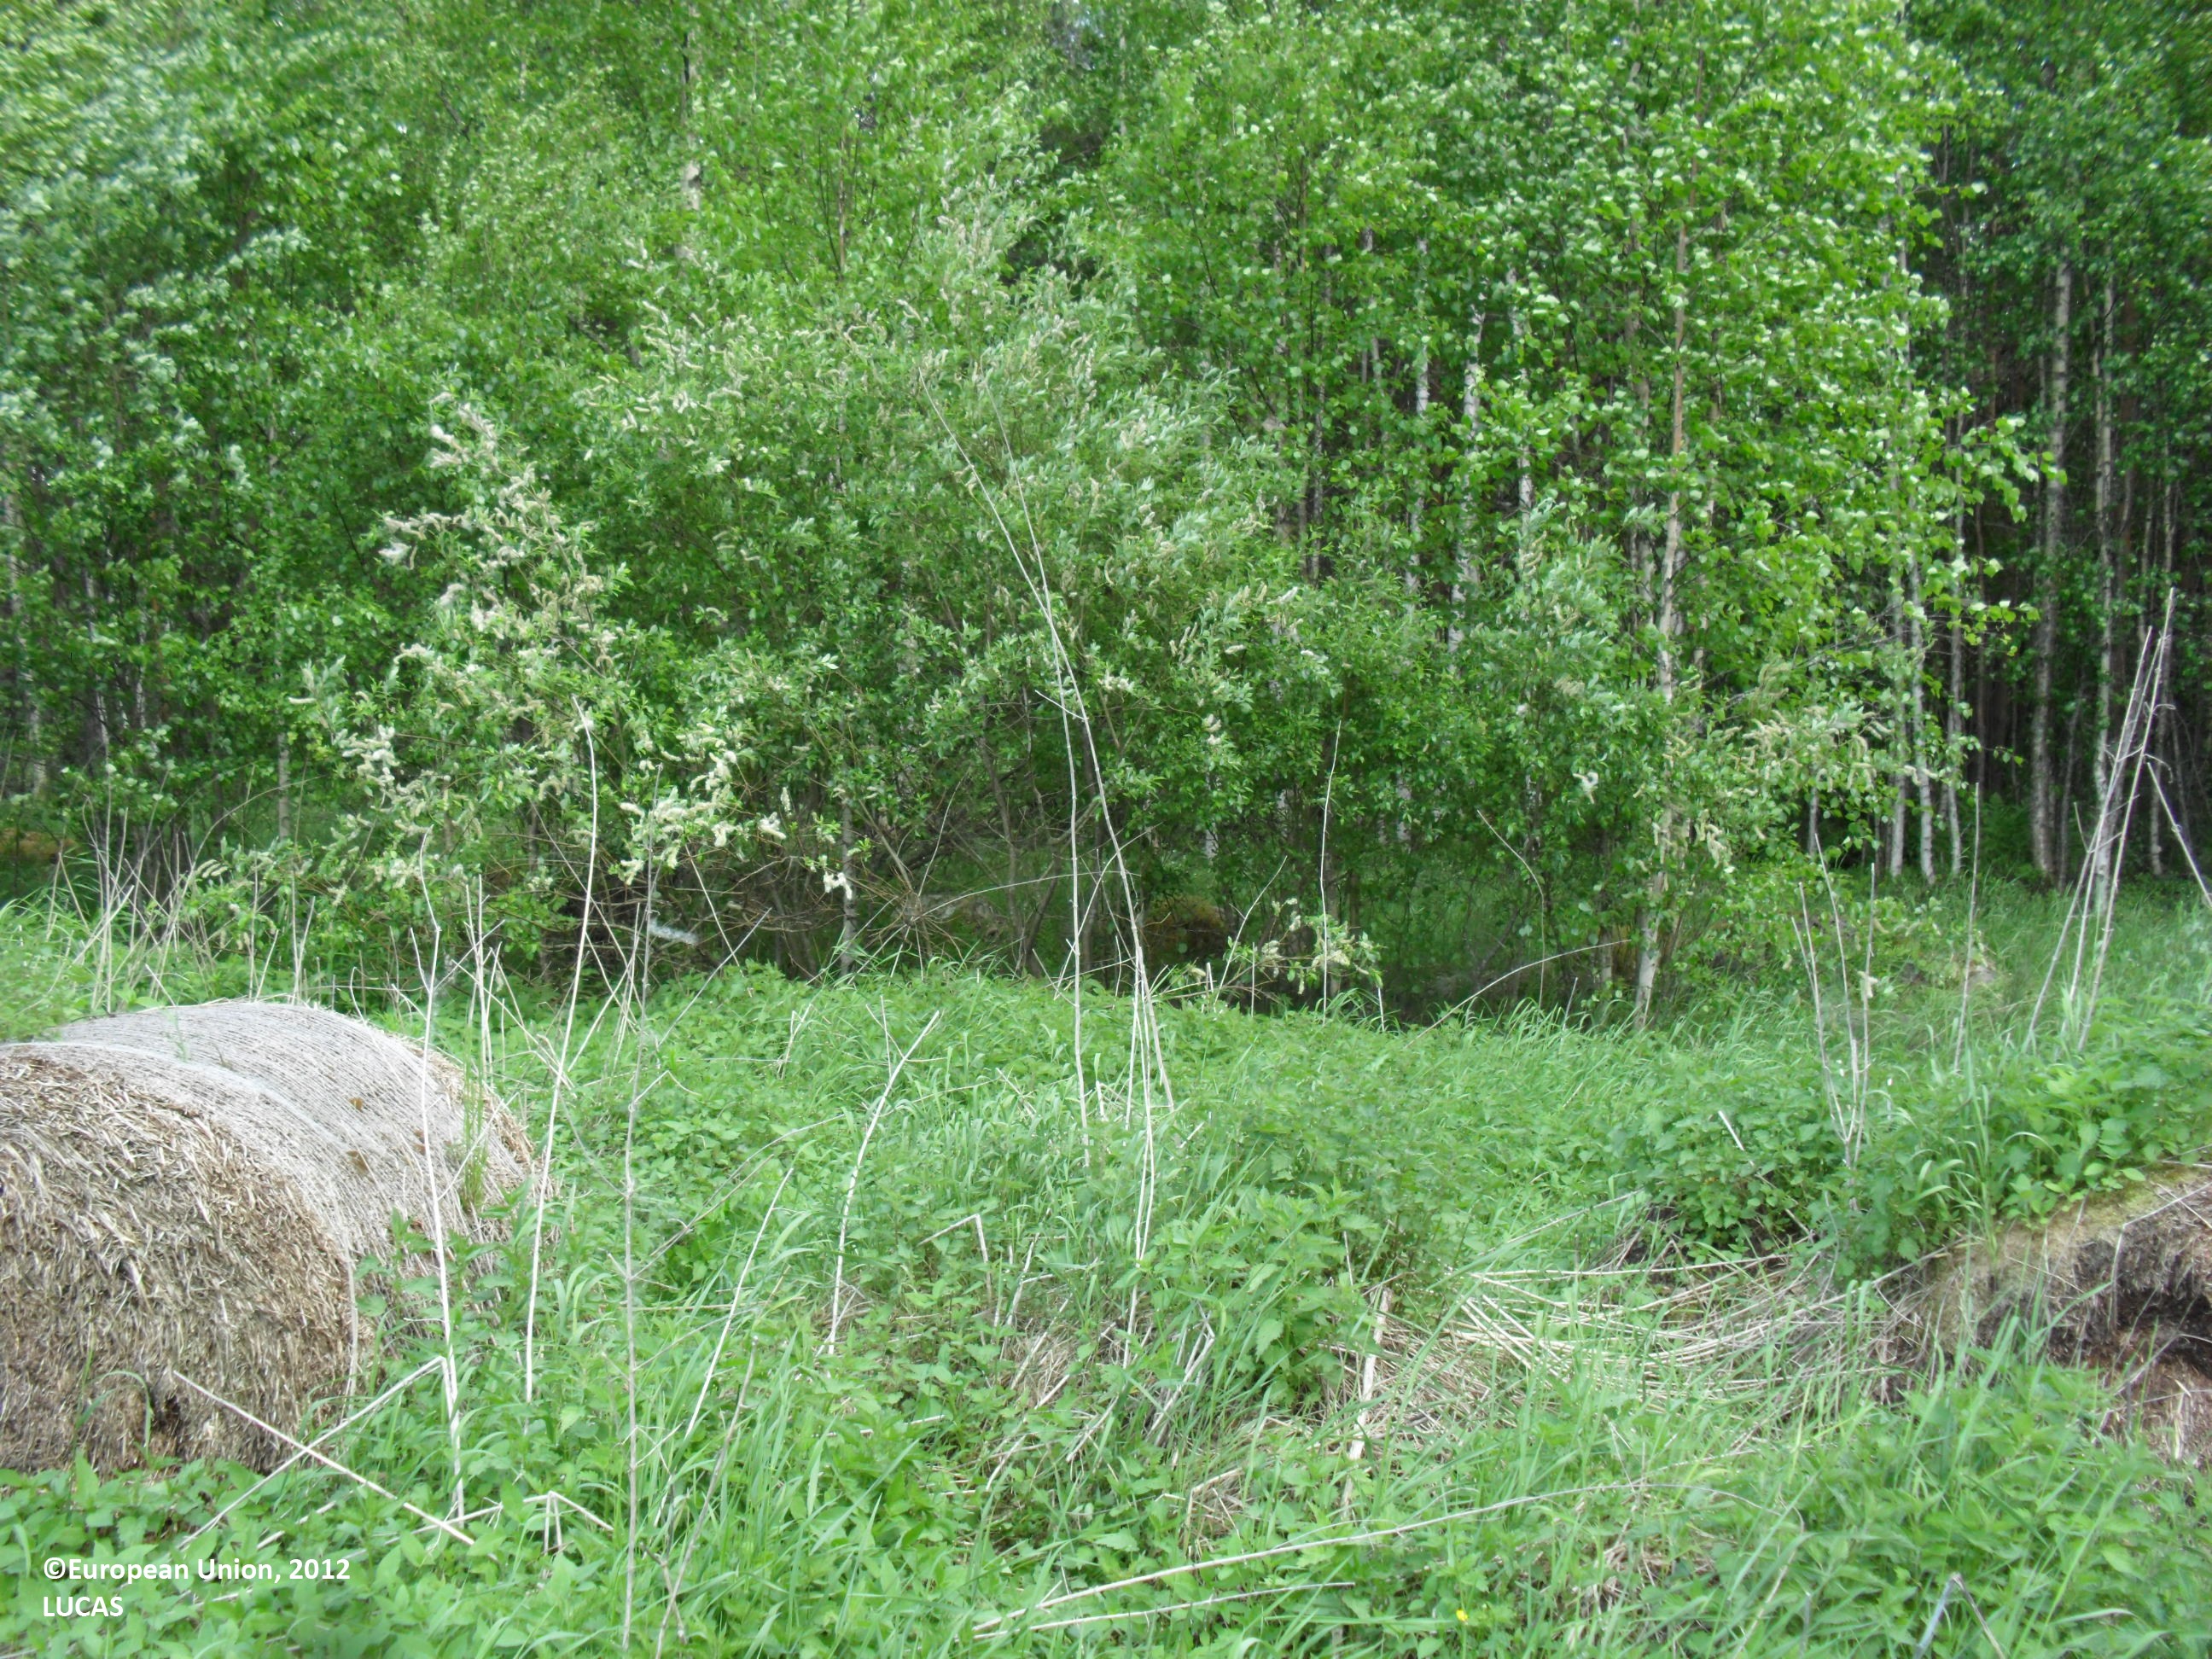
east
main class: Grassland
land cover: Grassland without tree/shrub cover
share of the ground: > 75 %
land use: Agriculture (excluding fallow land and kitchen gardens)
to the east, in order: Grassland without tree/shrub cover; Ditches and canals; Lines of trees; Paved roads, cycling and walking lanes; Pine dominated mixed woodland; Ditches and canals; Grass margins; Paved roads, cycling and walking lanes; Grass margins; Ditches and canals; Temporary grasslands; Rivers and streams; Temporary grasslands; Ditches and canals; Abandoned hedges; Temporary grasslands
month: June
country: FI
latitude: 62.8218
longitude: 23.5509
